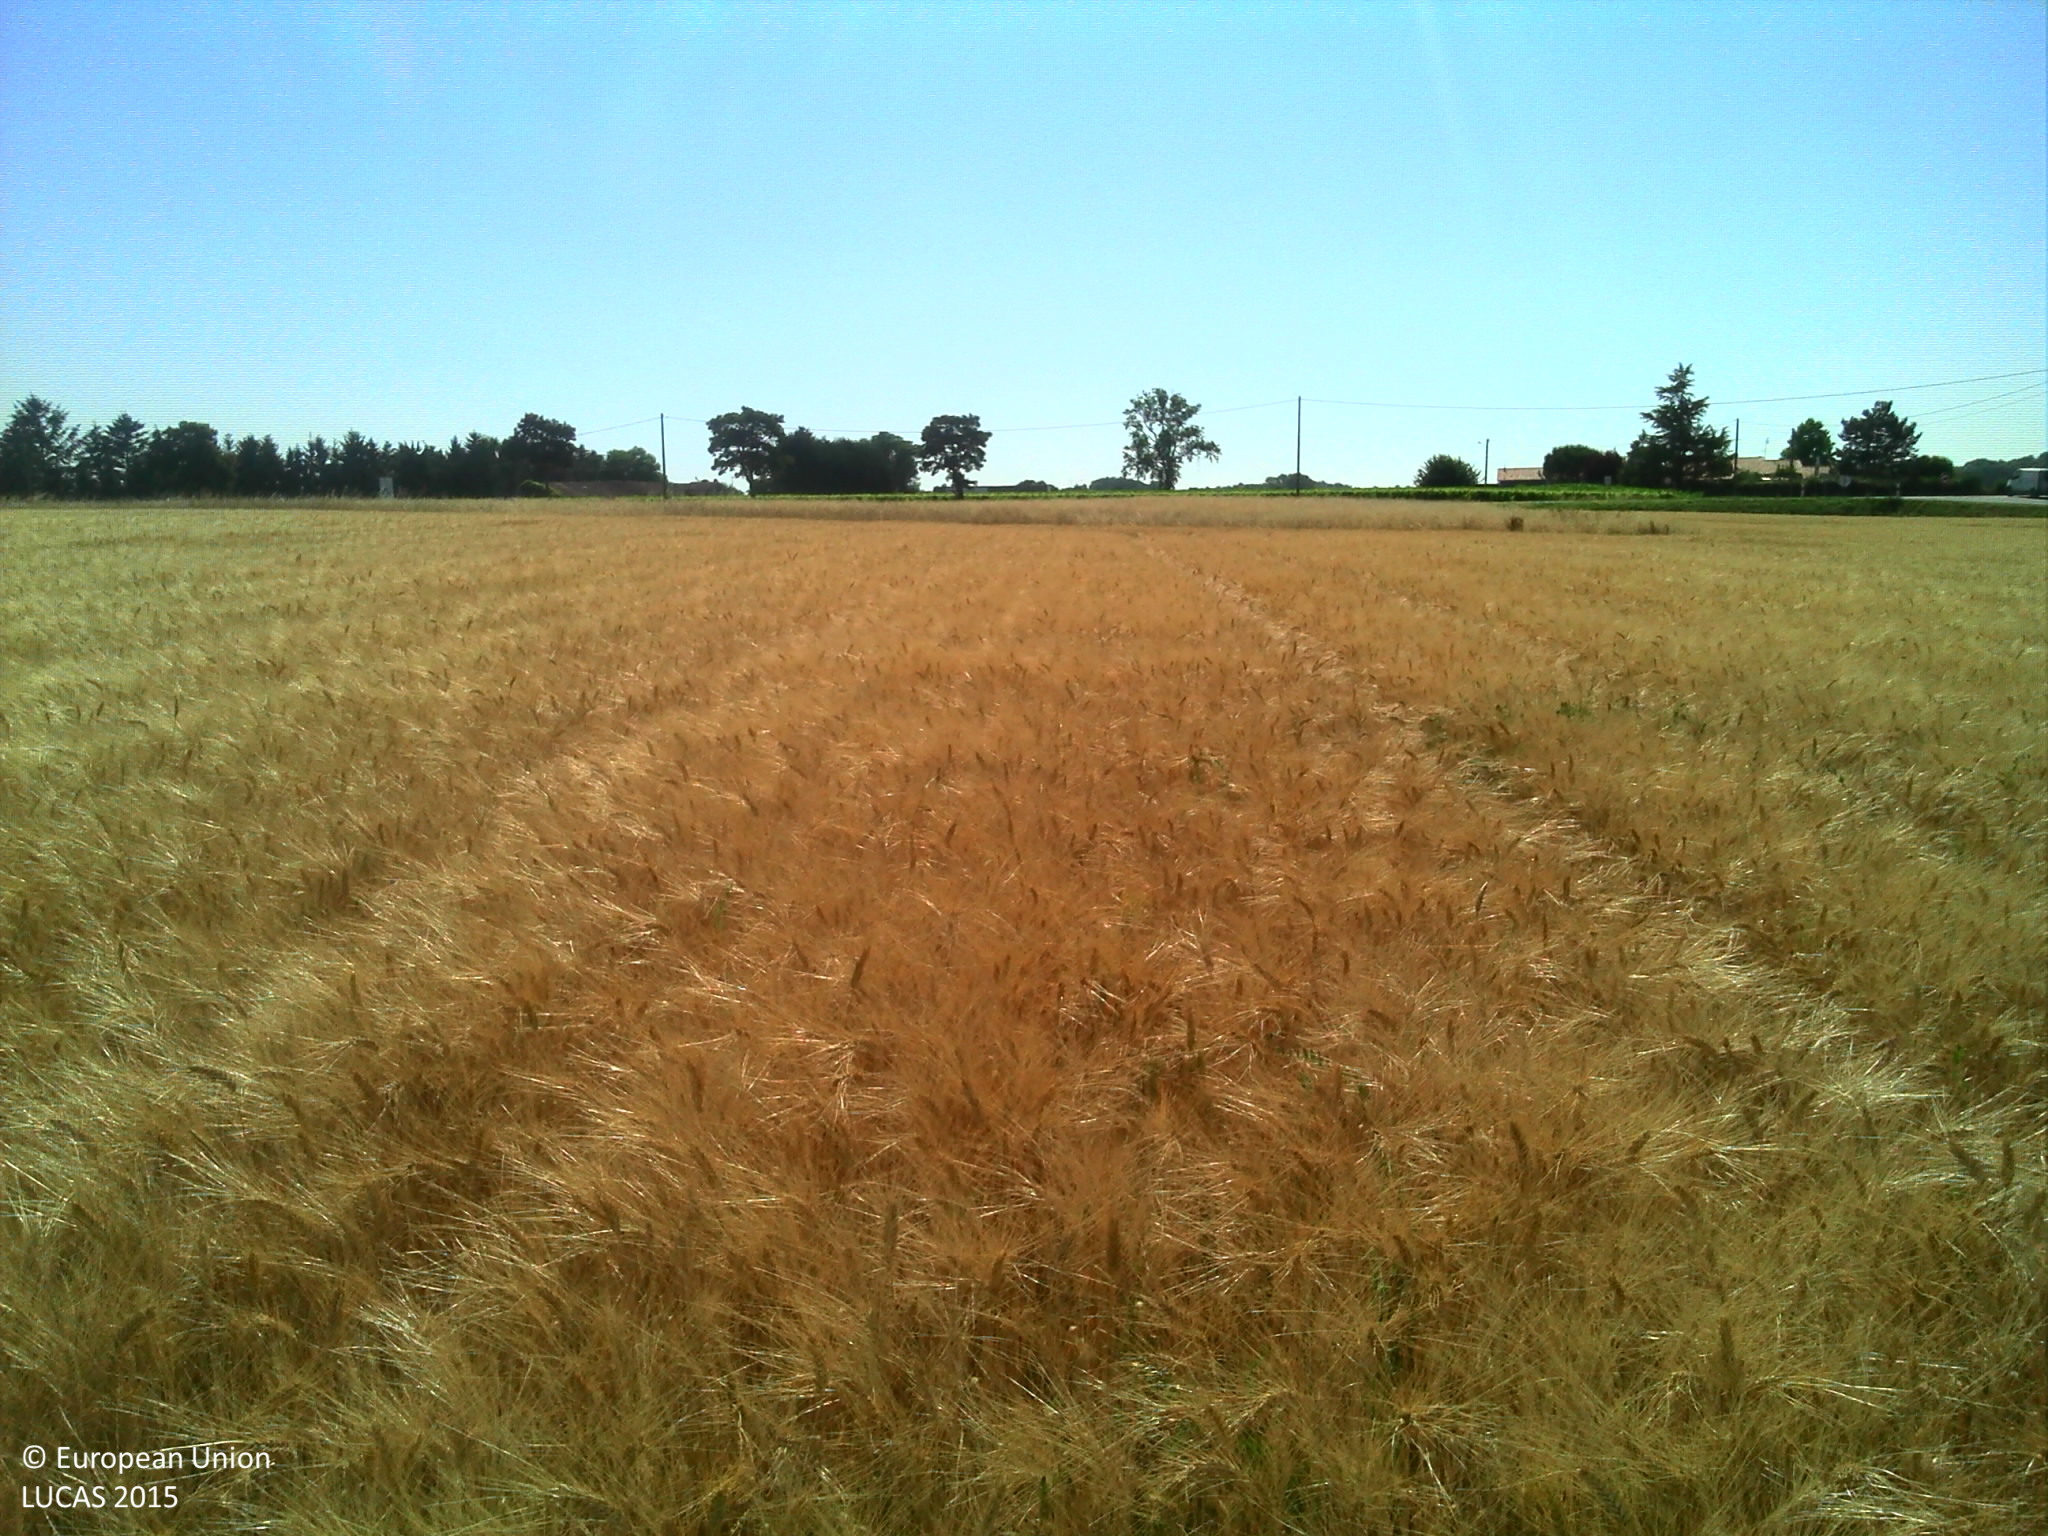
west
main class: Cropland
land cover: Durum wheat
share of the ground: > 75 %
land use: Agriculture (excluding fallow land and kitchen gardens)
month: June
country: FR
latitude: 45.5795
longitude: -0.6735
